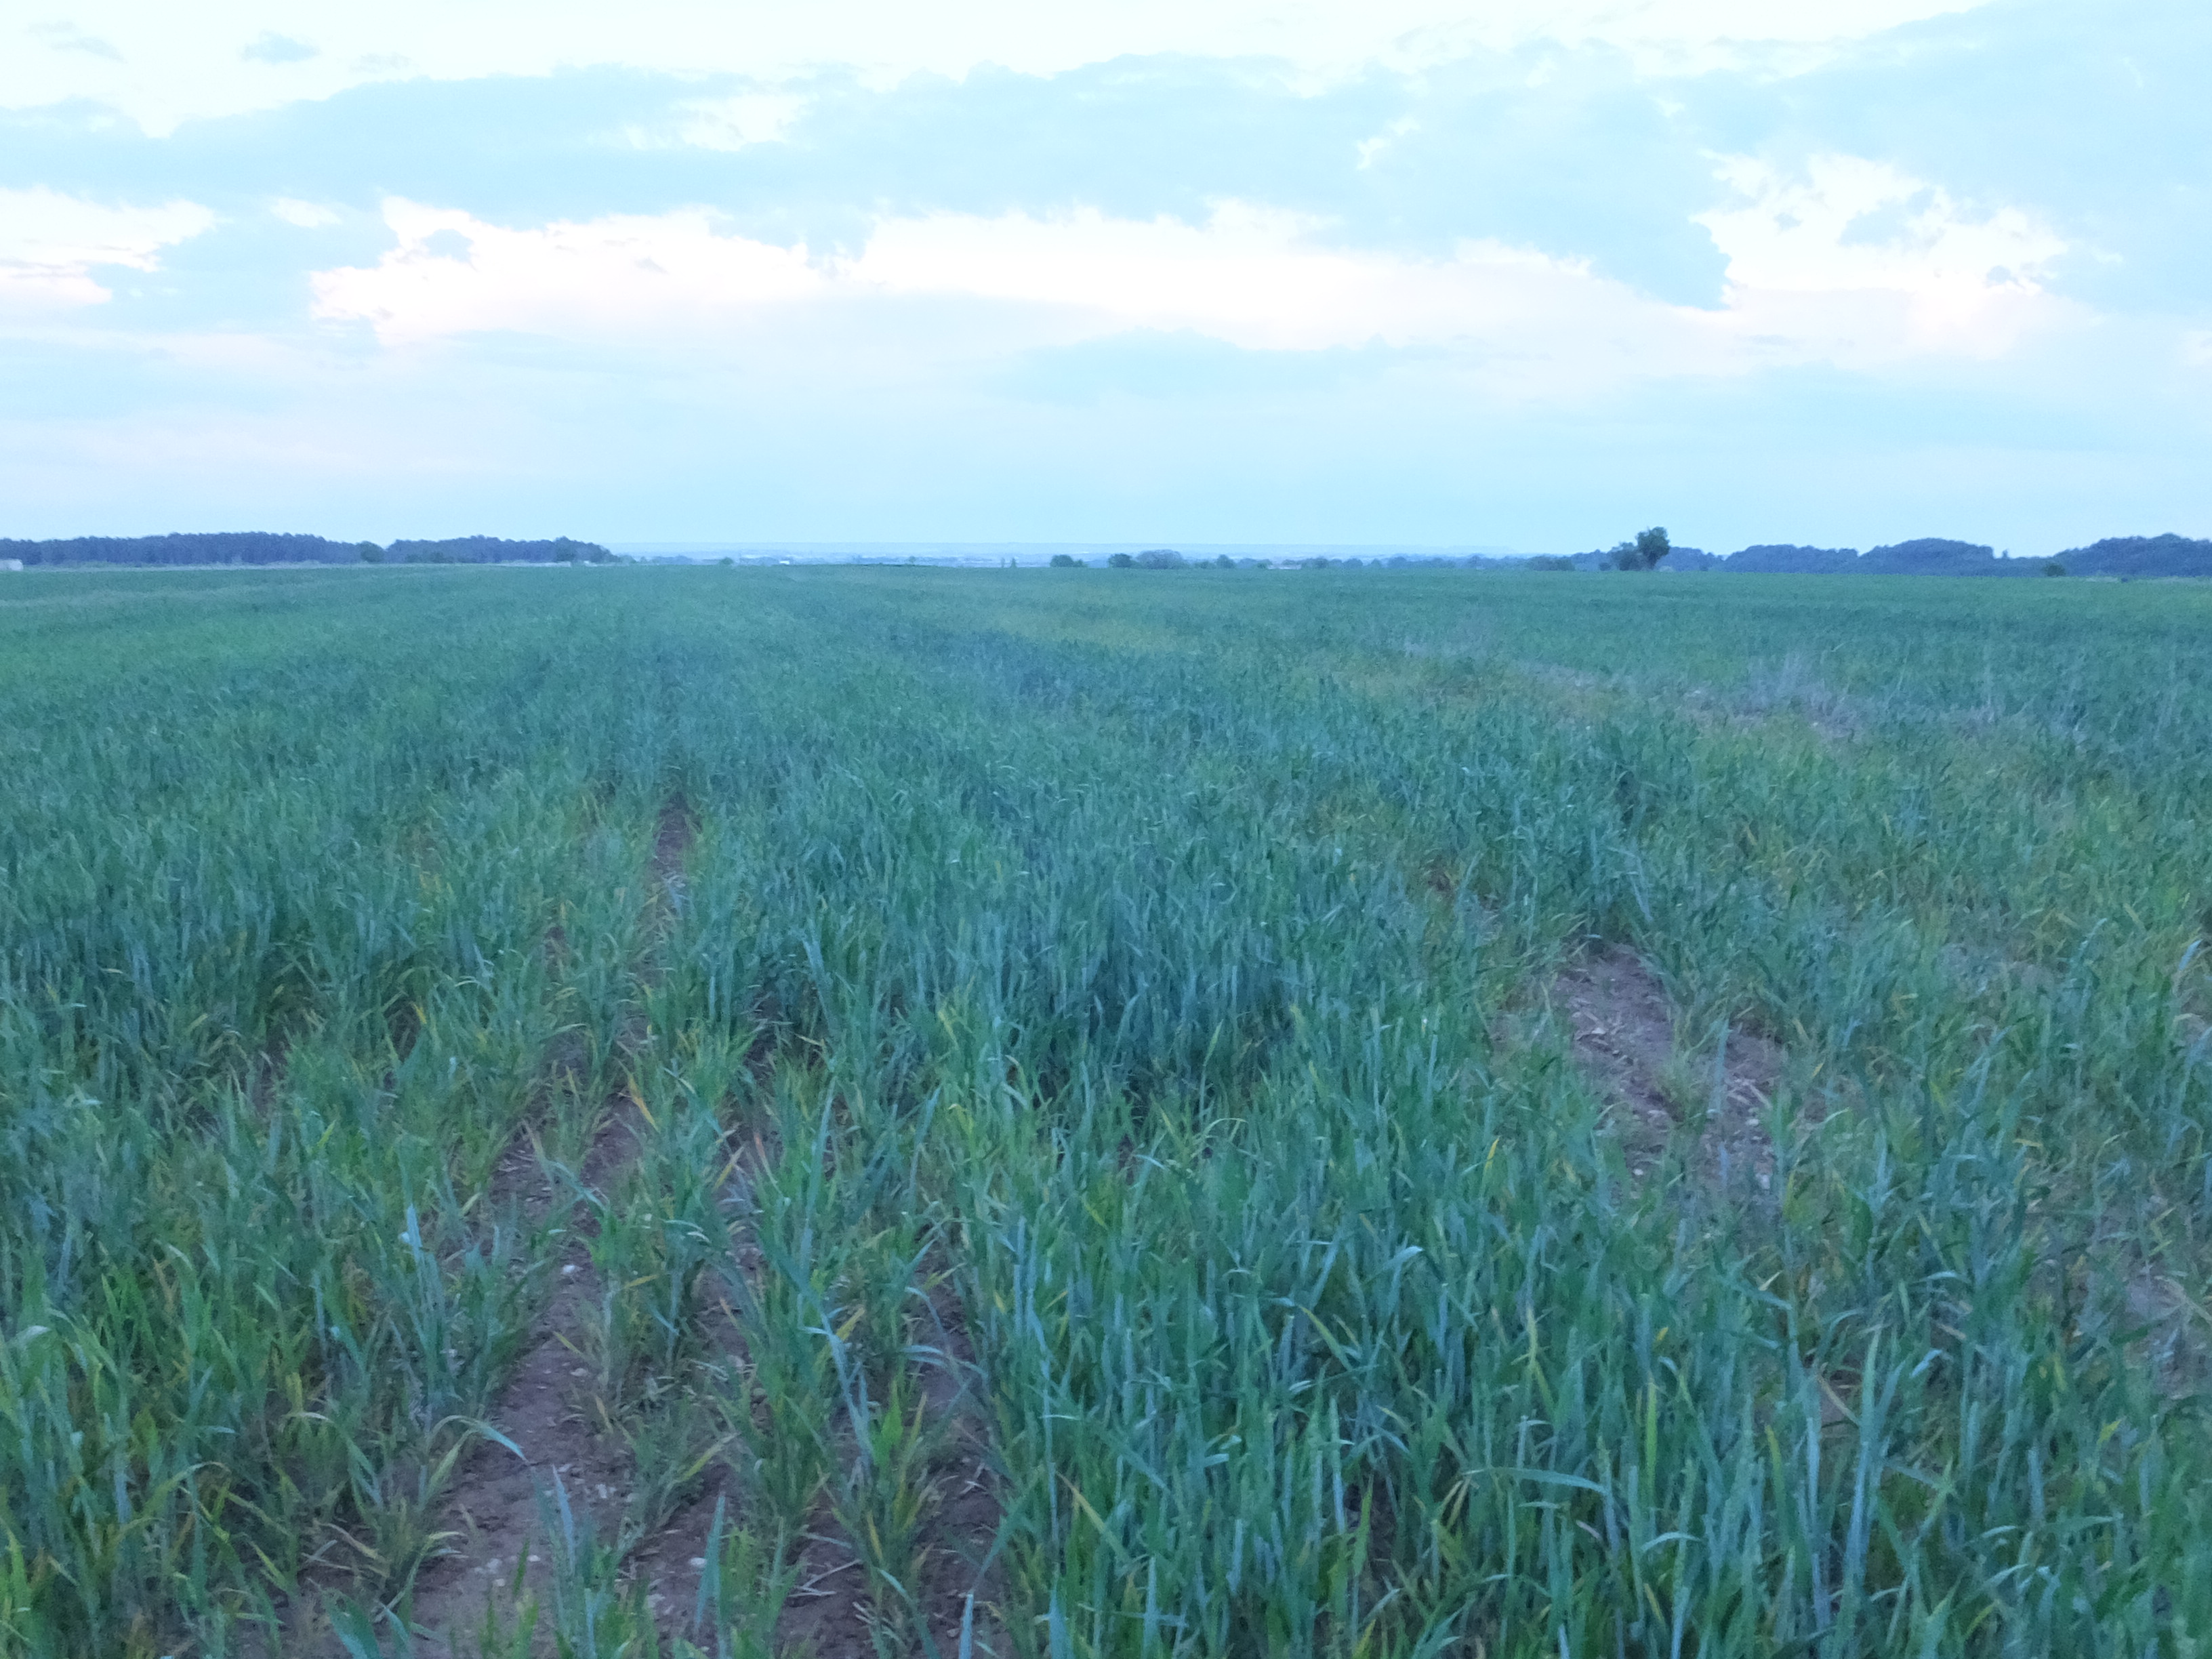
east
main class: Cropland
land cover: Common wheat
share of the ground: > 75 %
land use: Agriculture (excluding fallow land and kitchen gardens)
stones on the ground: < 10 %
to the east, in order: Common wheat; Grass margins; Durum wheat; Grass margins; Durum wheat; Grass margins; Durum wheat
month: April
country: ES
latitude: 41.7886
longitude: -0.2345
